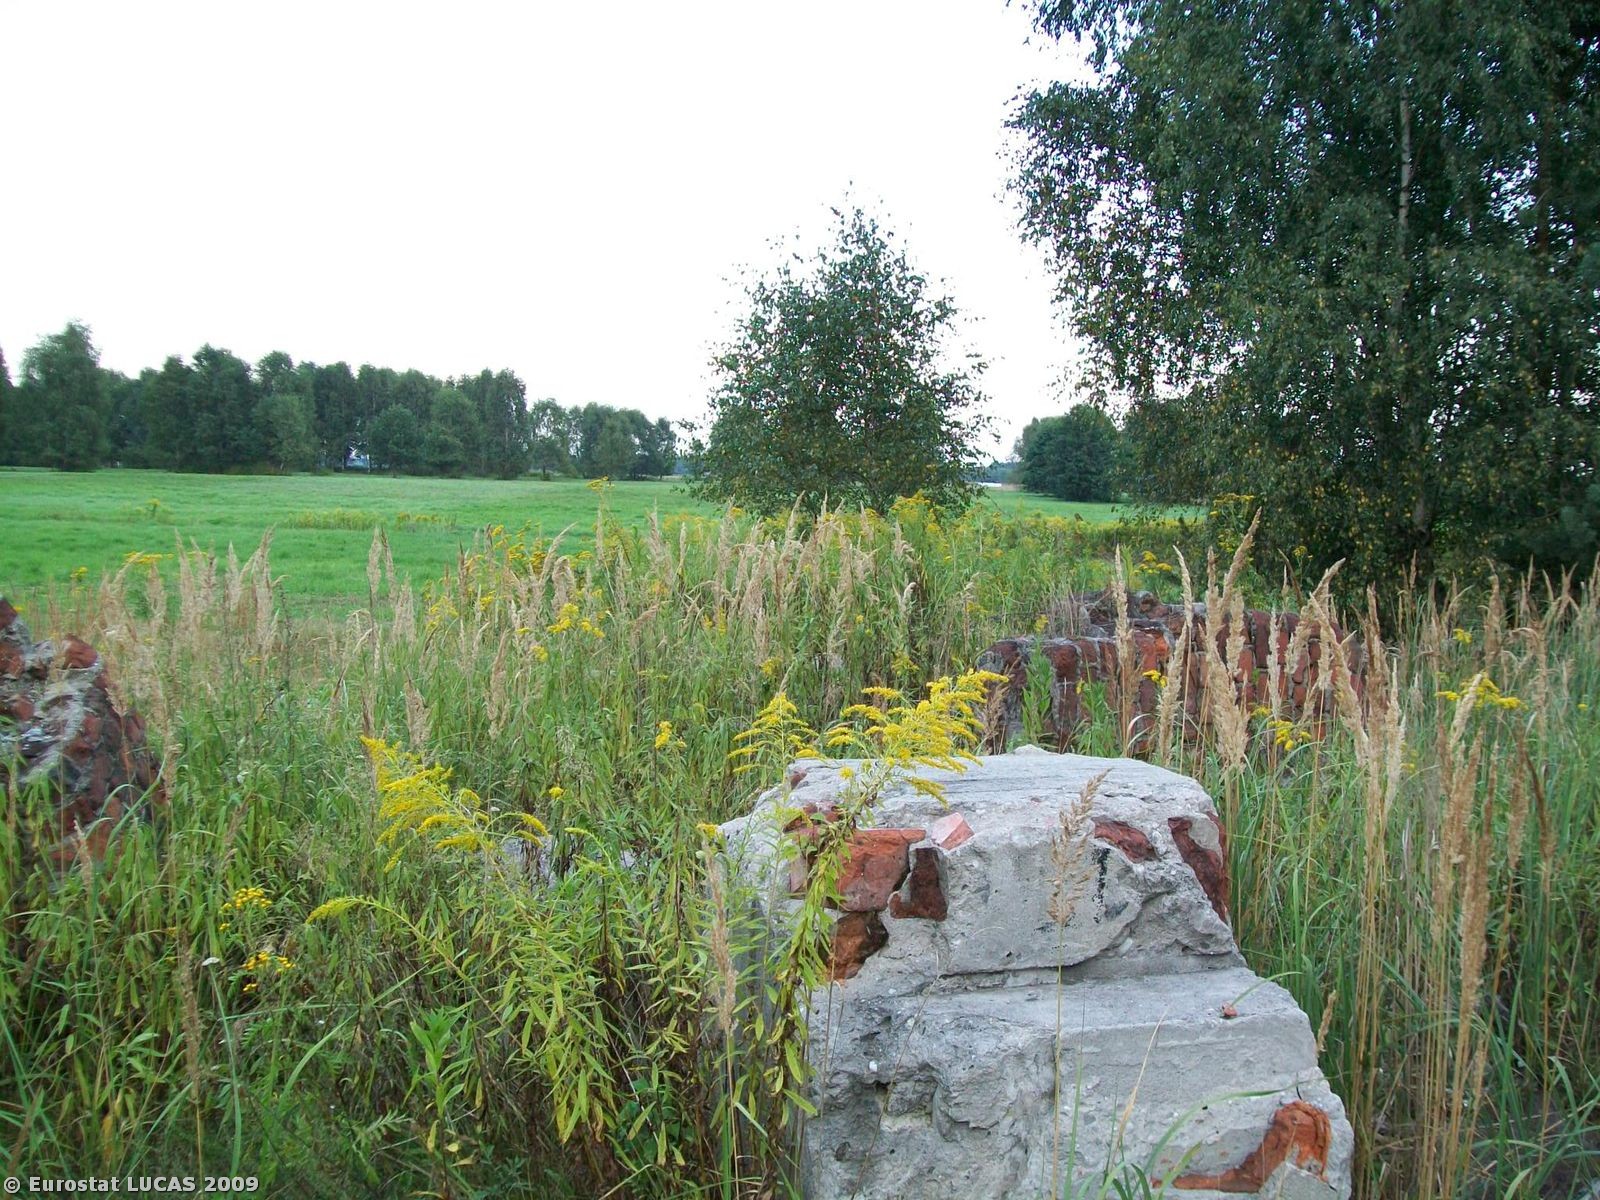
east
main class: Grassland
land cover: Spontaneously vegetated surfaces
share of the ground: > 75 %
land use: Unused
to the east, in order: Spontaneously vegetated surfaces; Single bushes/trees; Grassland without tree/shrub cover; Ditches and canals; Grassland without tree/shrub cover; Abandoned hedges; Grassland without tree/shrub cover
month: August
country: PL
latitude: 50.9388
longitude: 17.9135
